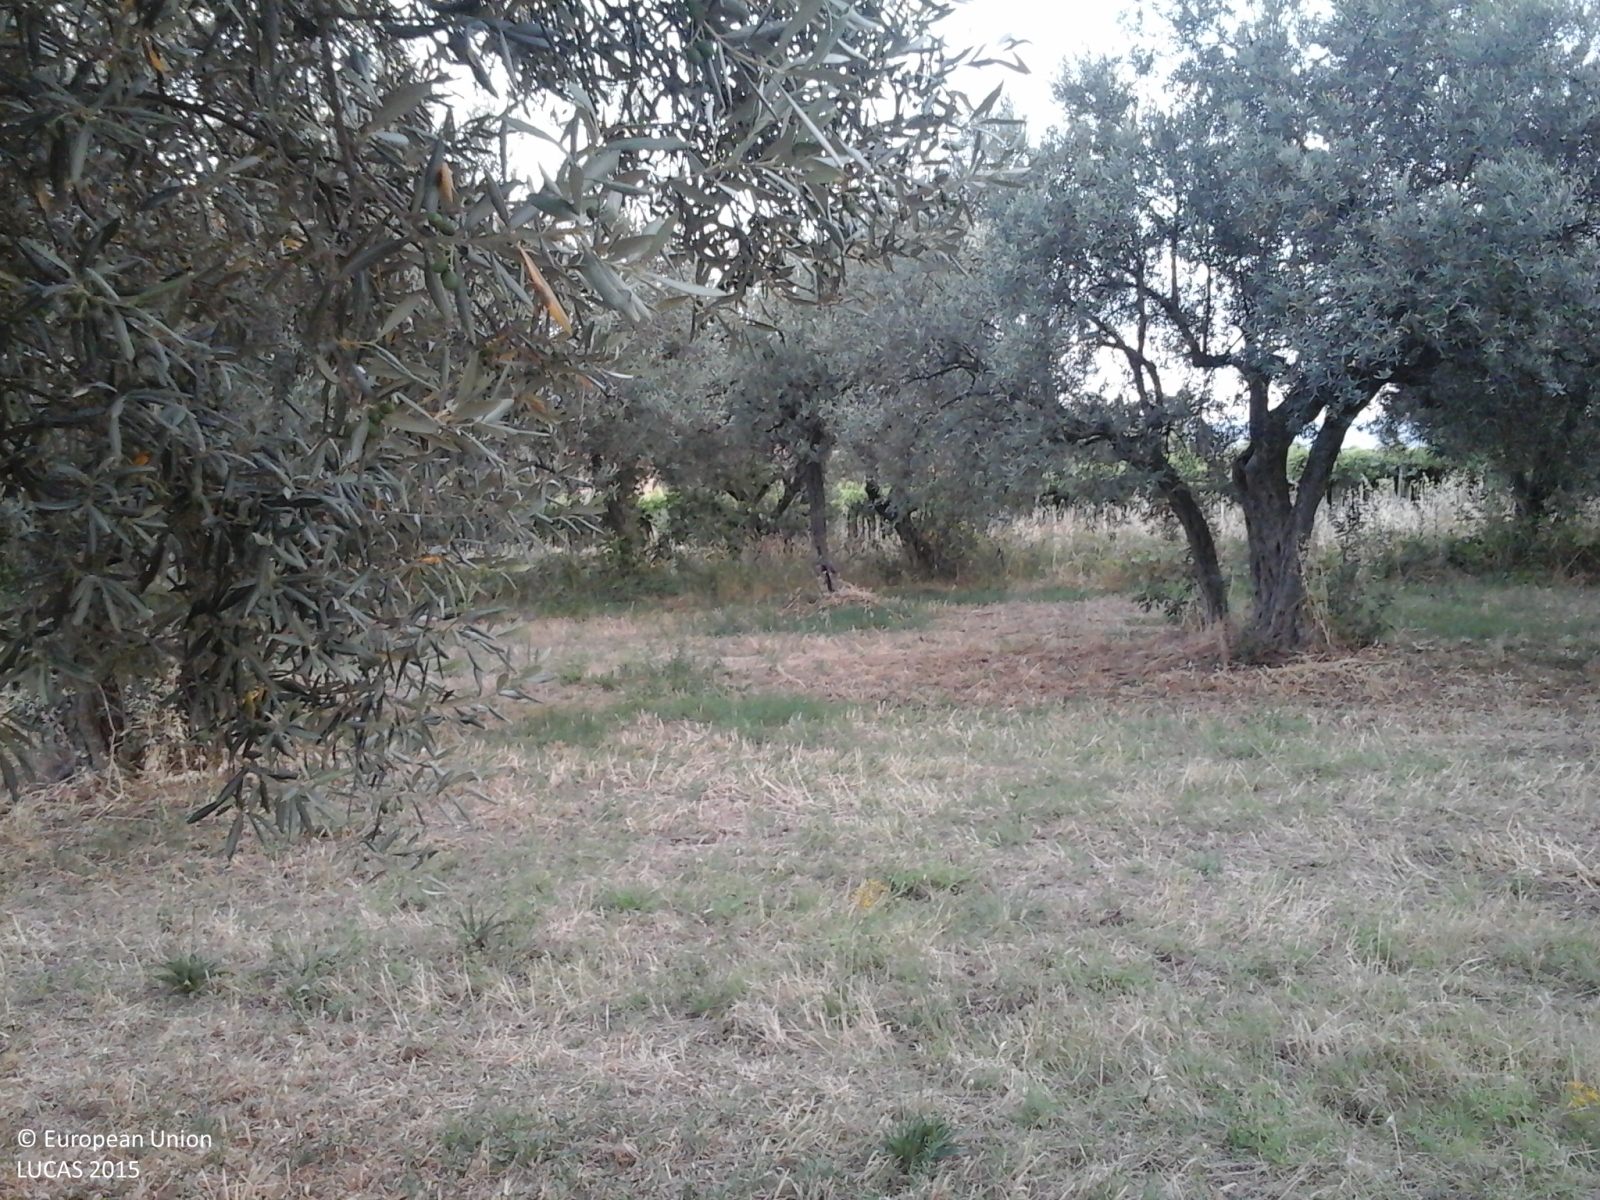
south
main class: Cropland
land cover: Olive groves
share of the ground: 25 - 50 %
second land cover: Spontaneously vegetated surfaces
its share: > 75 %
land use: Agriculture (excluding fallow land and kitchen gardens)
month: June
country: IT
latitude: 42.2366
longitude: 14.3128
